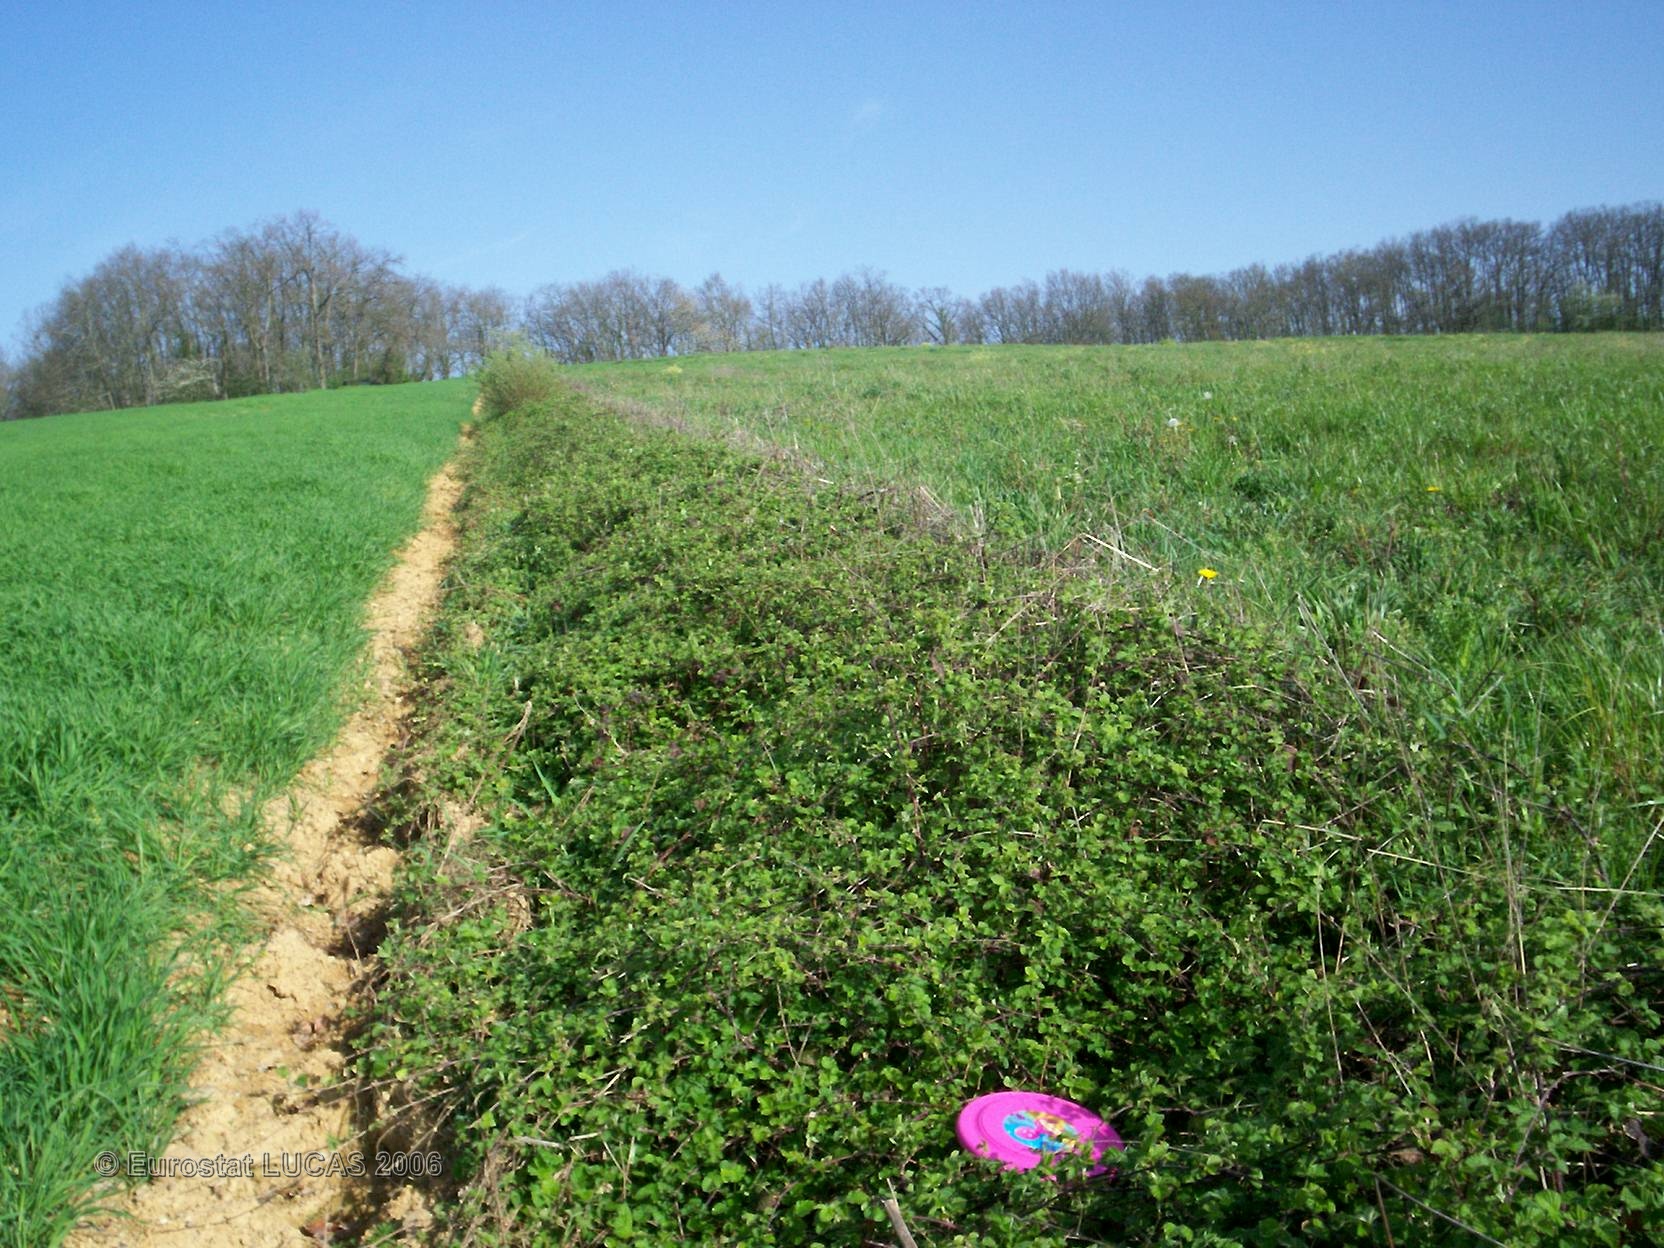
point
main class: Grassland
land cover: Grassland without tree/shrub cover
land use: Agriculture (excluding fallow land and kitchen gardens)
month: April
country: FR
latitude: 43.3897
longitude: 0.3315
